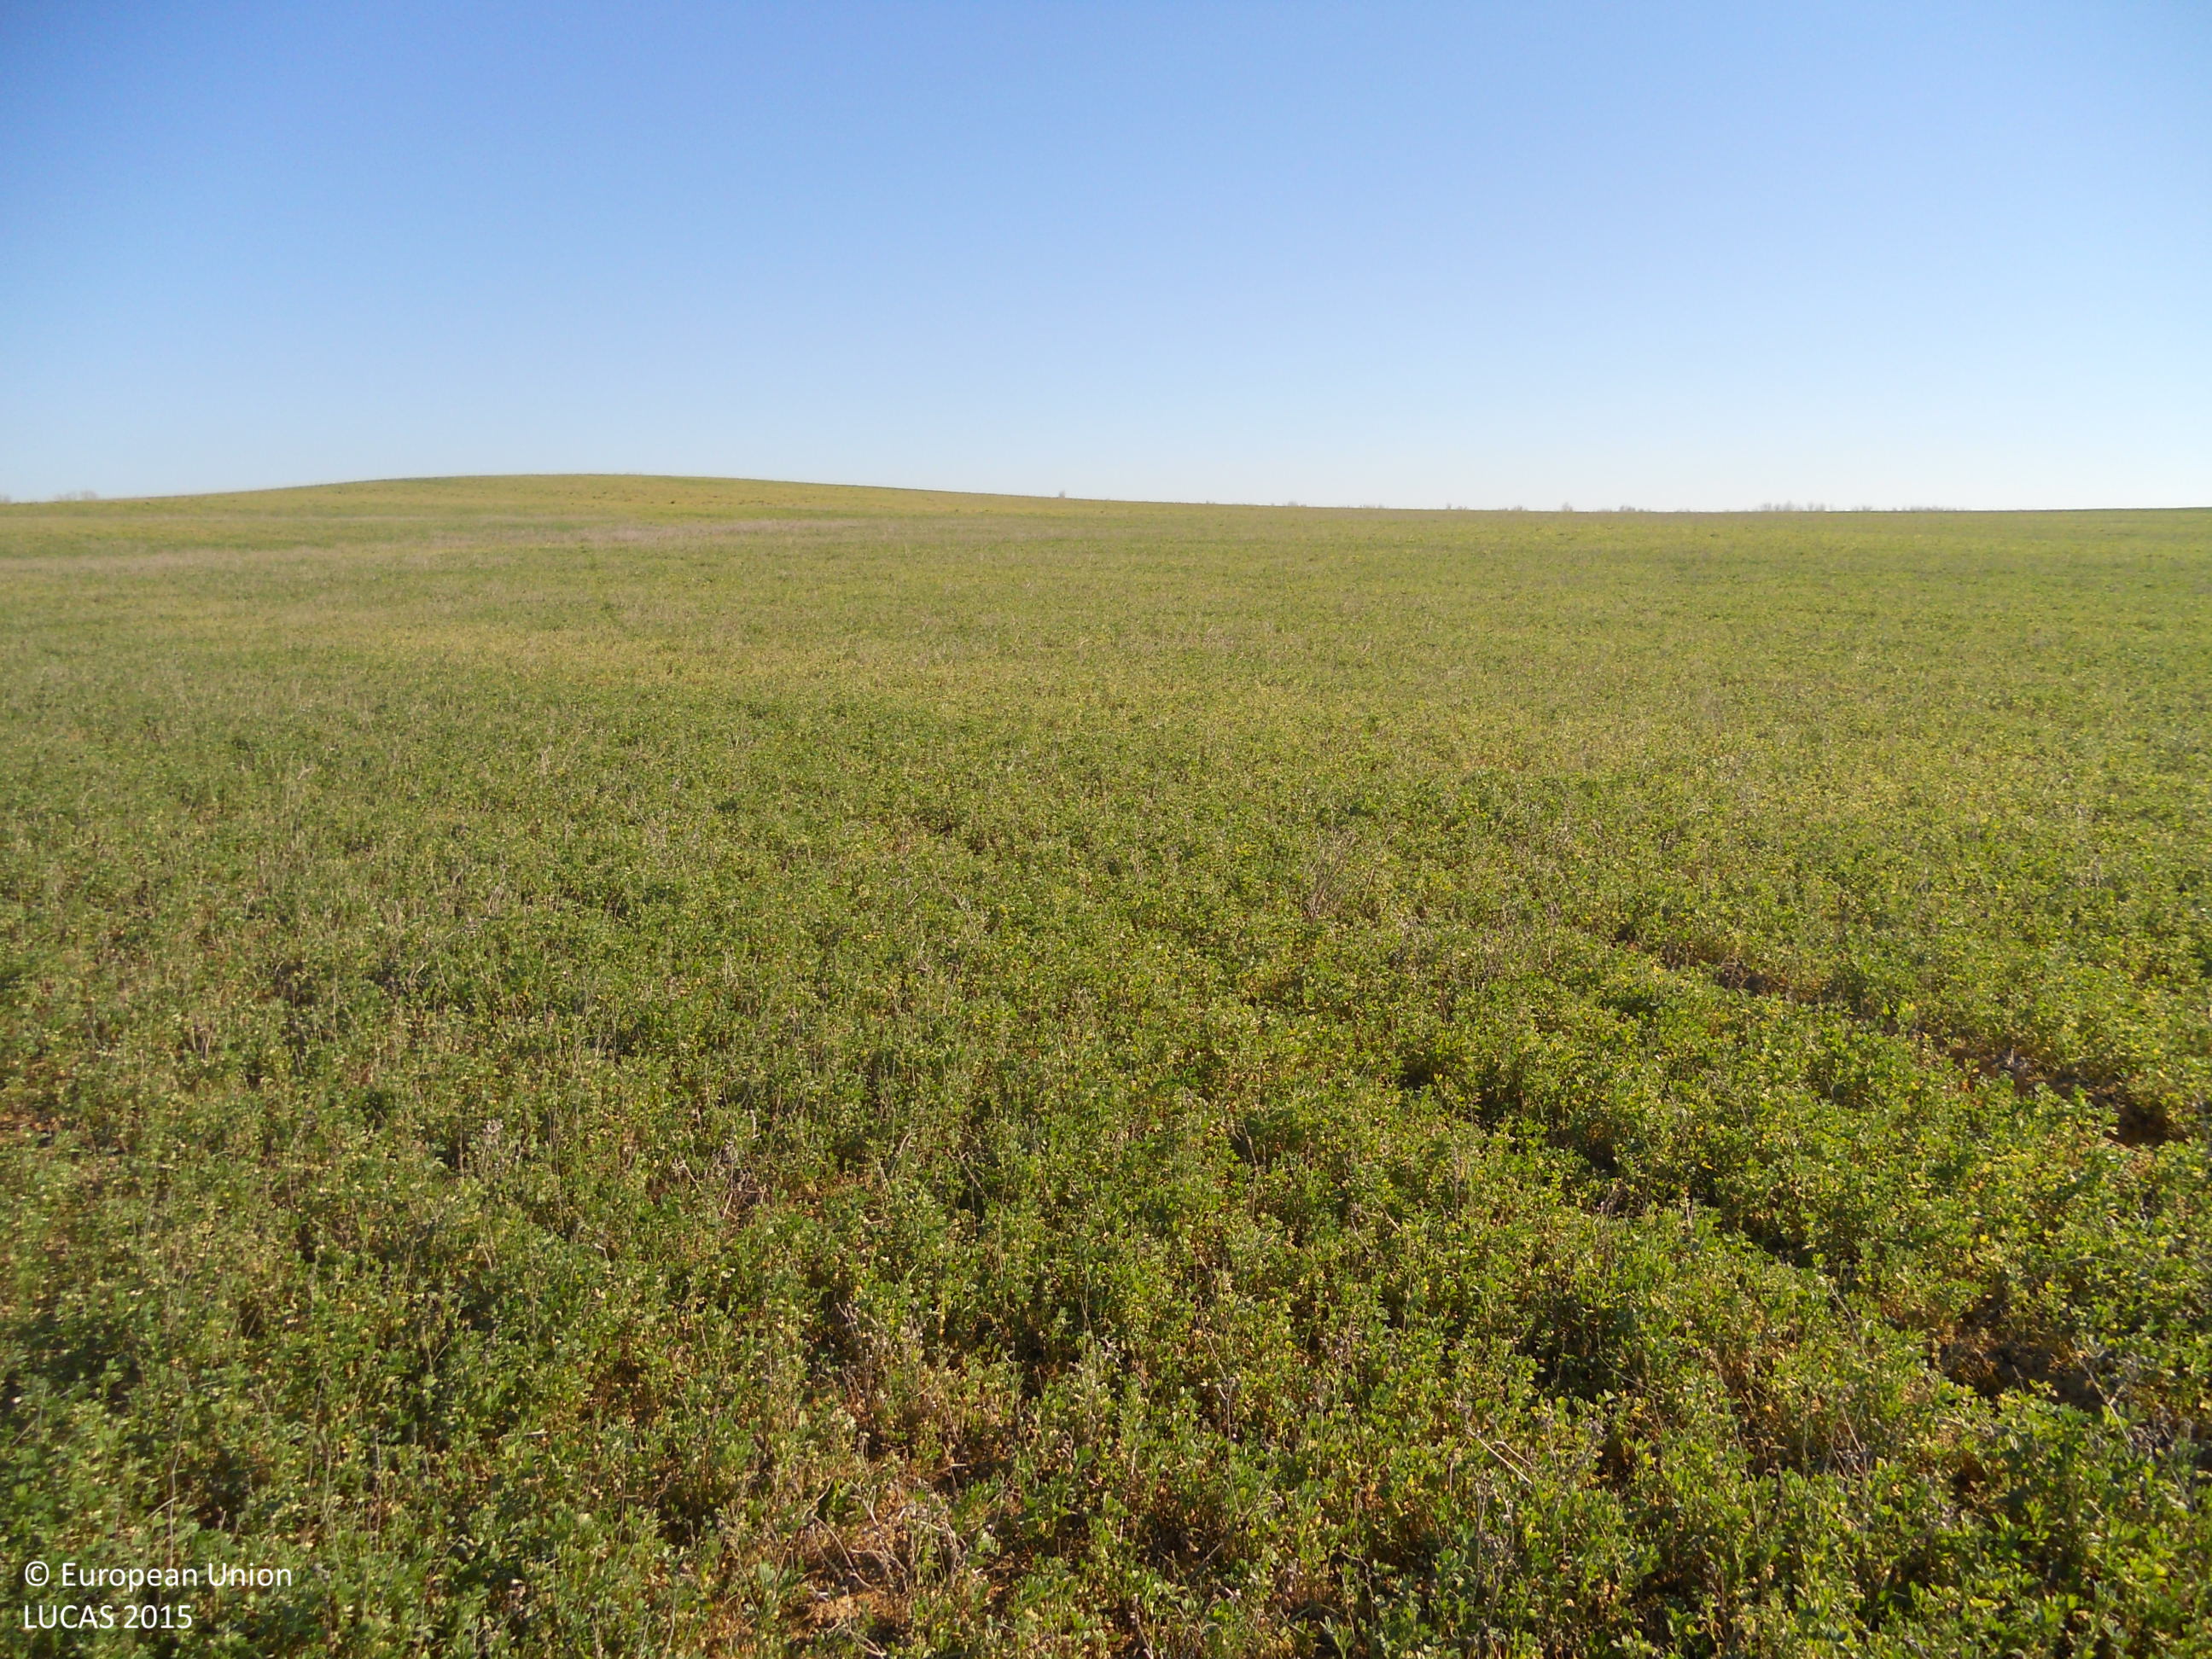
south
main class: Cropland
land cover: Lucerne
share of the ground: > 75 %
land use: Agriculture (excluding fallow land and kitchen gardens)
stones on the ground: < 10 %
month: April
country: ES
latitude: 42.2652
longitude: -4.3636
